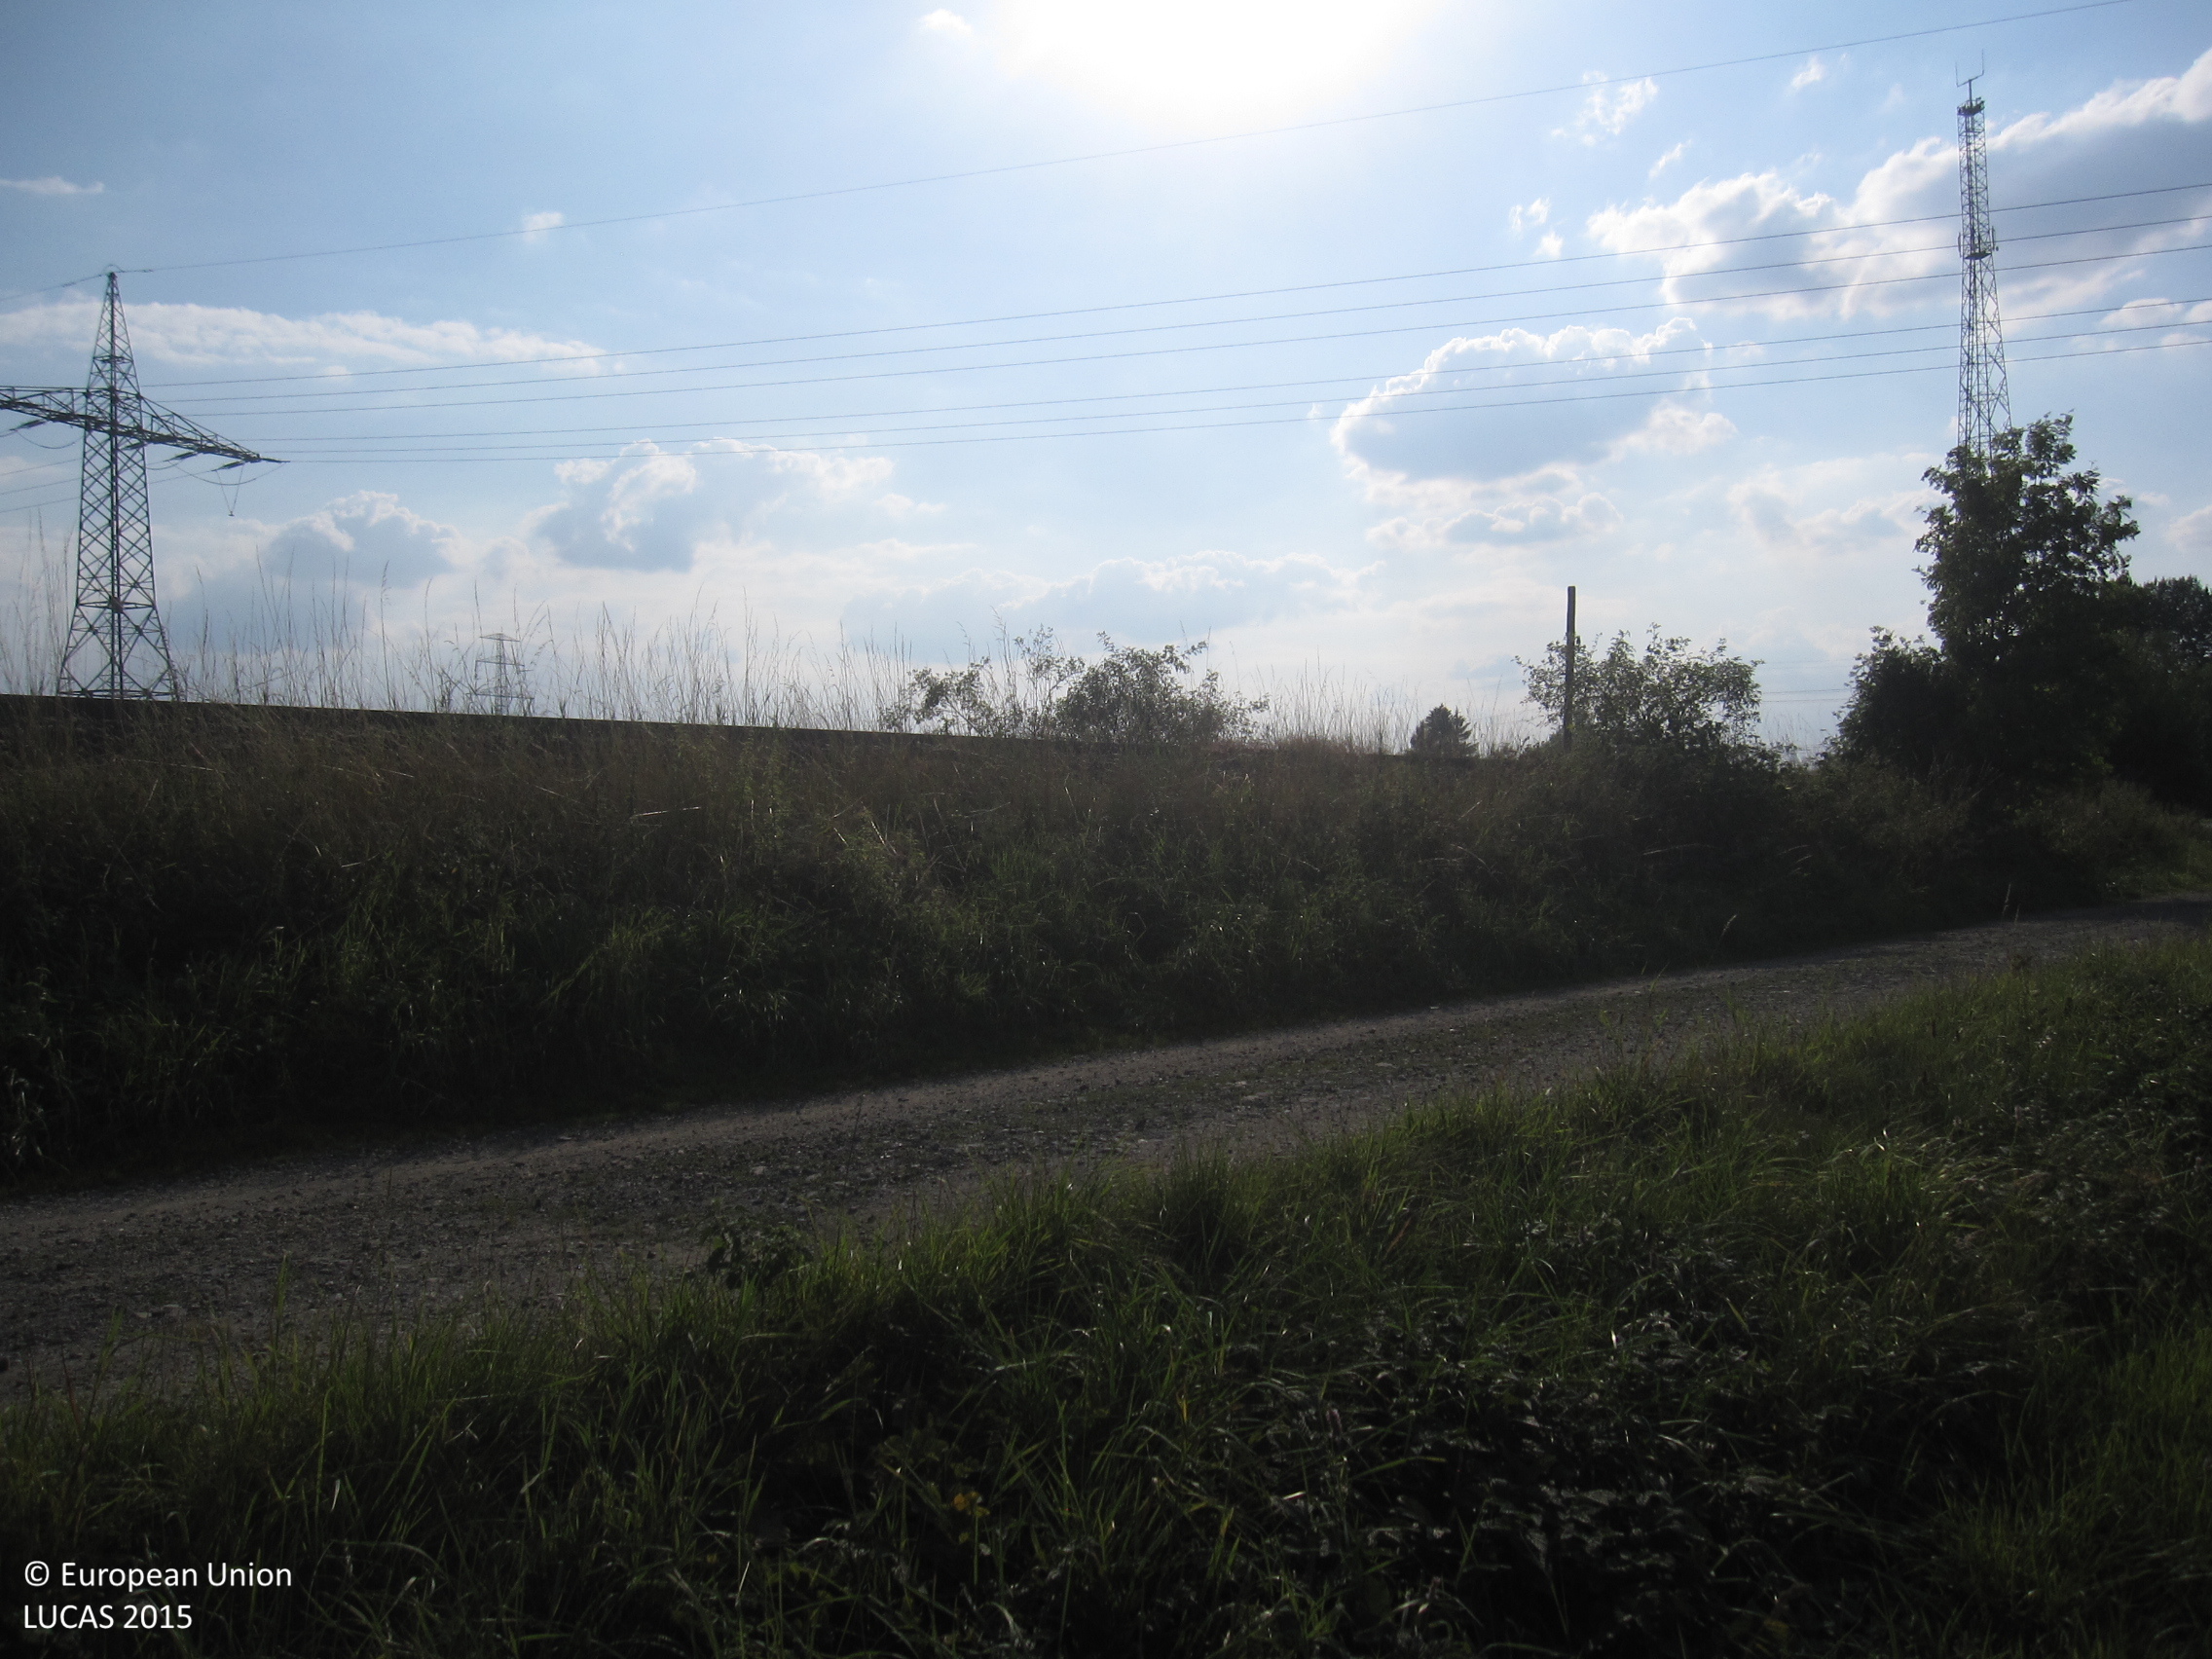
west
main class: Grassland
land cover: Grassland without tree/shrub cover
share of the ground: > 75 %
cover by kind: herbaceous plants 100 %
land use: Agriculture (excluding fallow land and kitchen gardens)
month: August
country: DE
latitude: 50.5320
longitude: 11.6502
